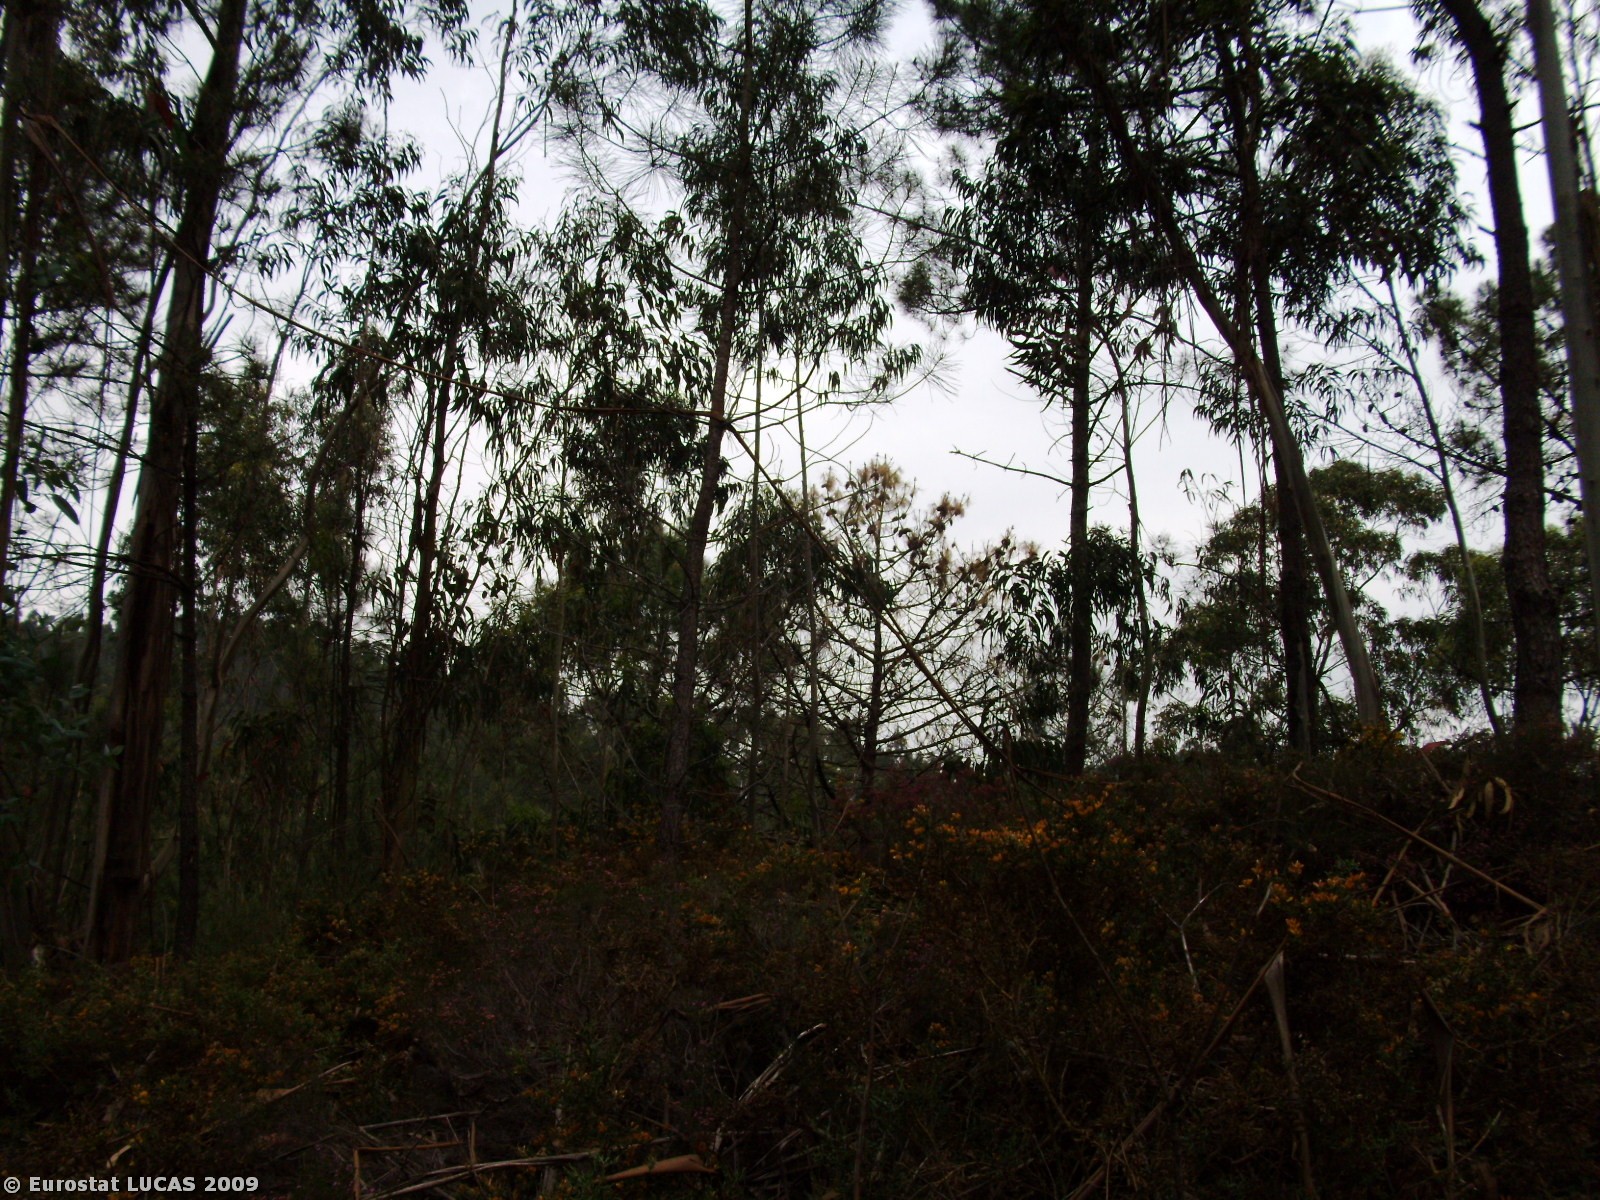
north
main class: Woodland
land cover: Broadleaved woodland
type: plantations and self-sown exotic forest
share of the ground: > 75 %
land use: Forestry
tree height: > 5 m
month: May
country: PT
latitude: 40.3558
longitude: -8.3220
